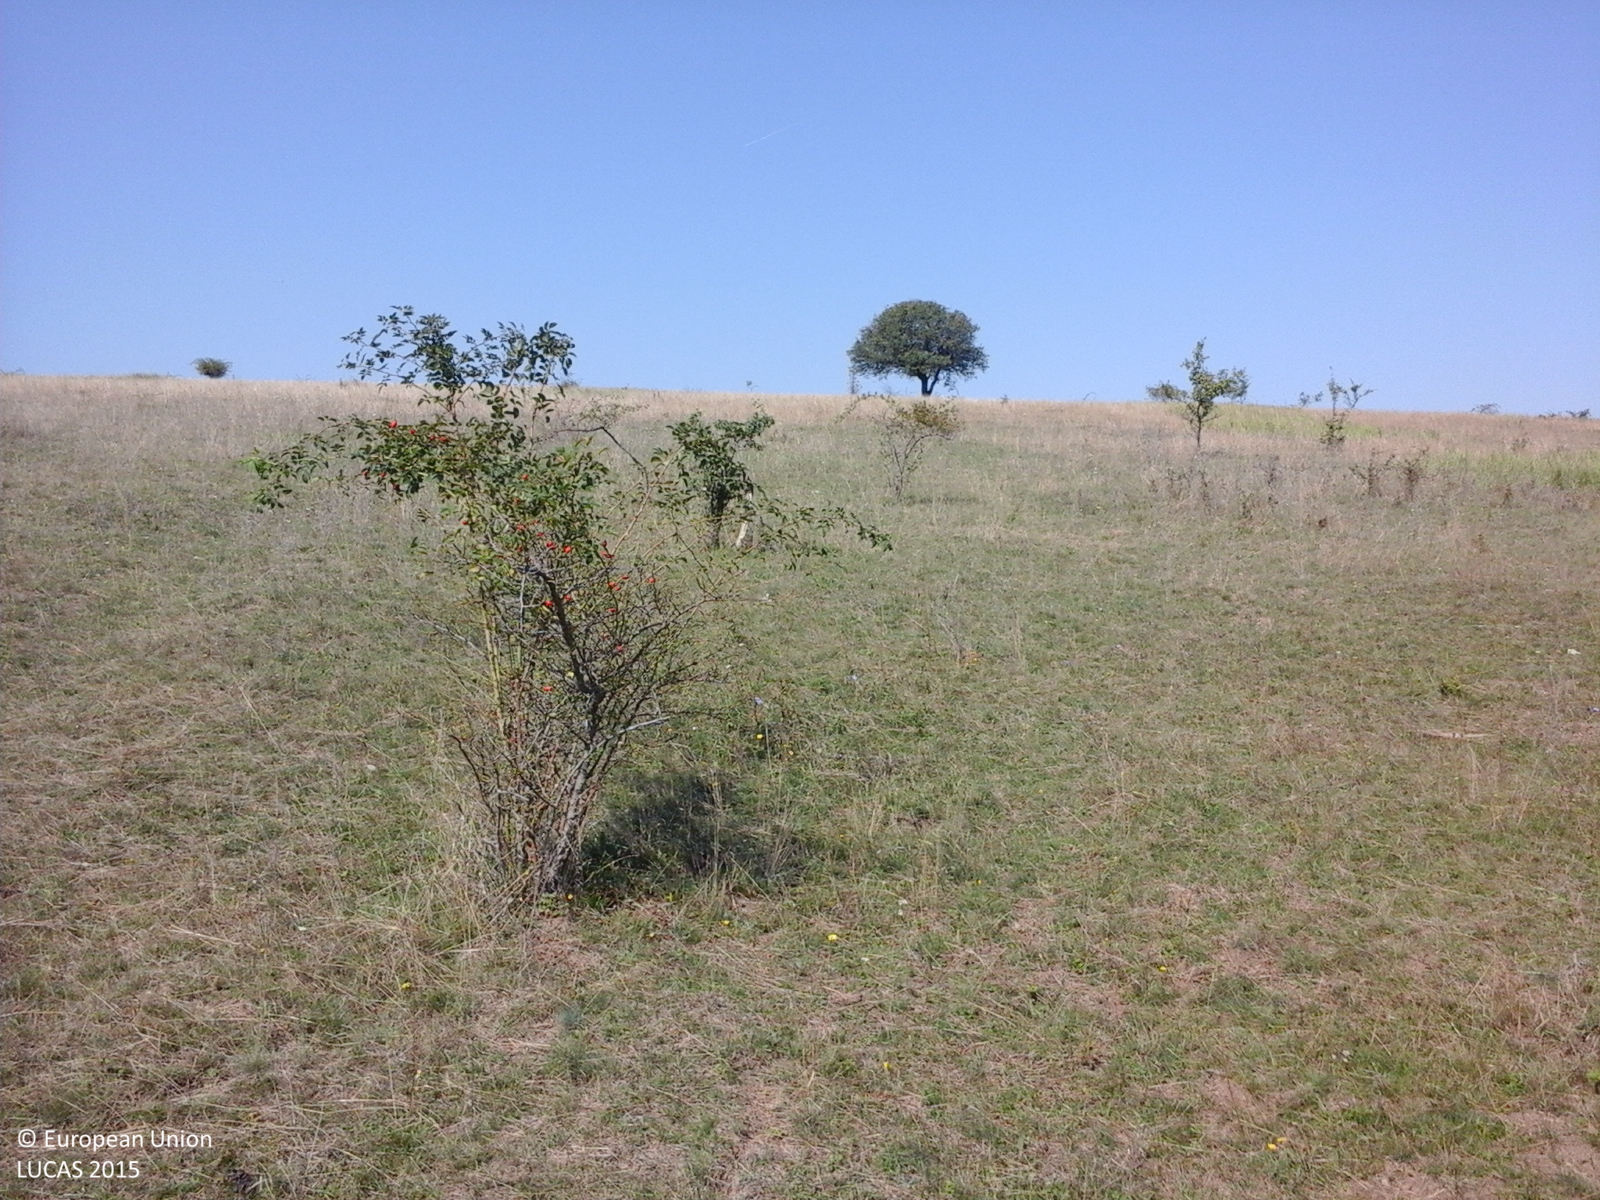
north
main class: Grassland
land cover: Grassland with sparse tree/shrub cover
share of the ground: > 75 %
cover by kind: herbaceous plants 90 %, broadleaved forest trees 5 %, shrubs 5 %
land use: Agriculture (excluding fallow land and kitchen gardens)
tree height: < 5 m
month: September
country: RO
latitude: 47.3222
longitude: 22.6944
